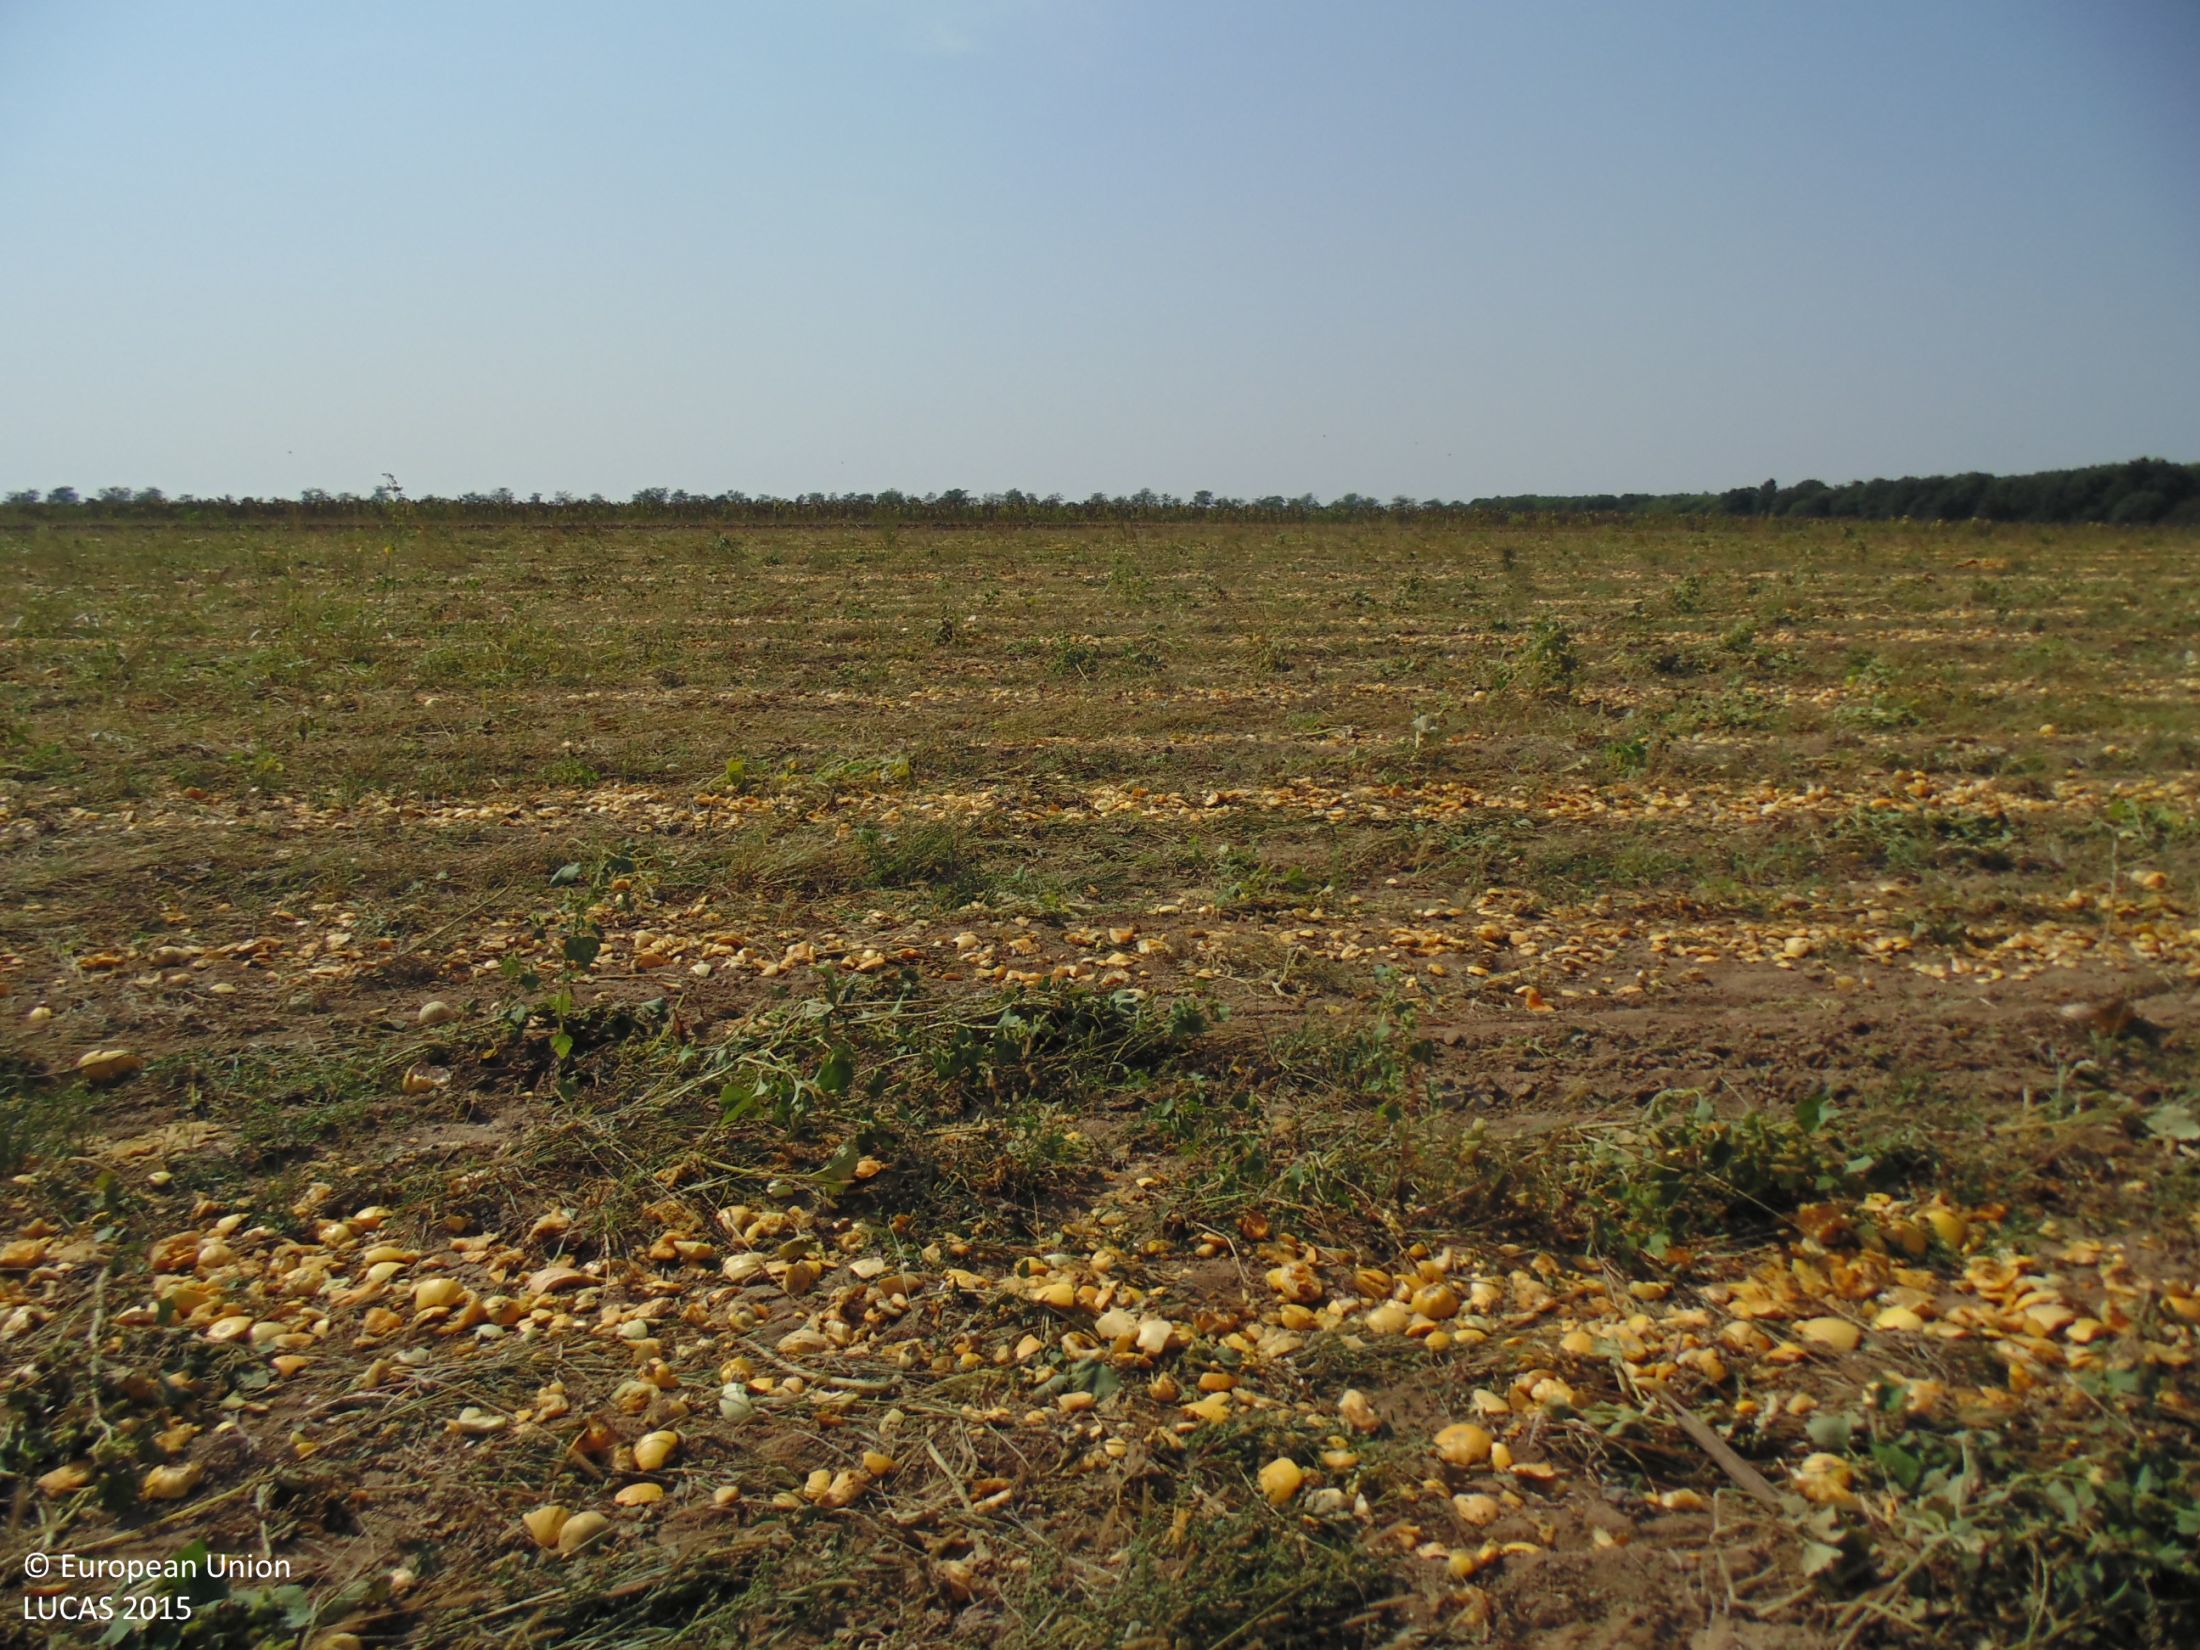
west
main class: Cropland
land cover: Other fresh vegetables
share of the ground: 25 - 50 %
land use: Agriculture (excluding fallow land and kitchen gardens)
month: September
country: BG
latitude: 43.8453
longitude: 26.9496
